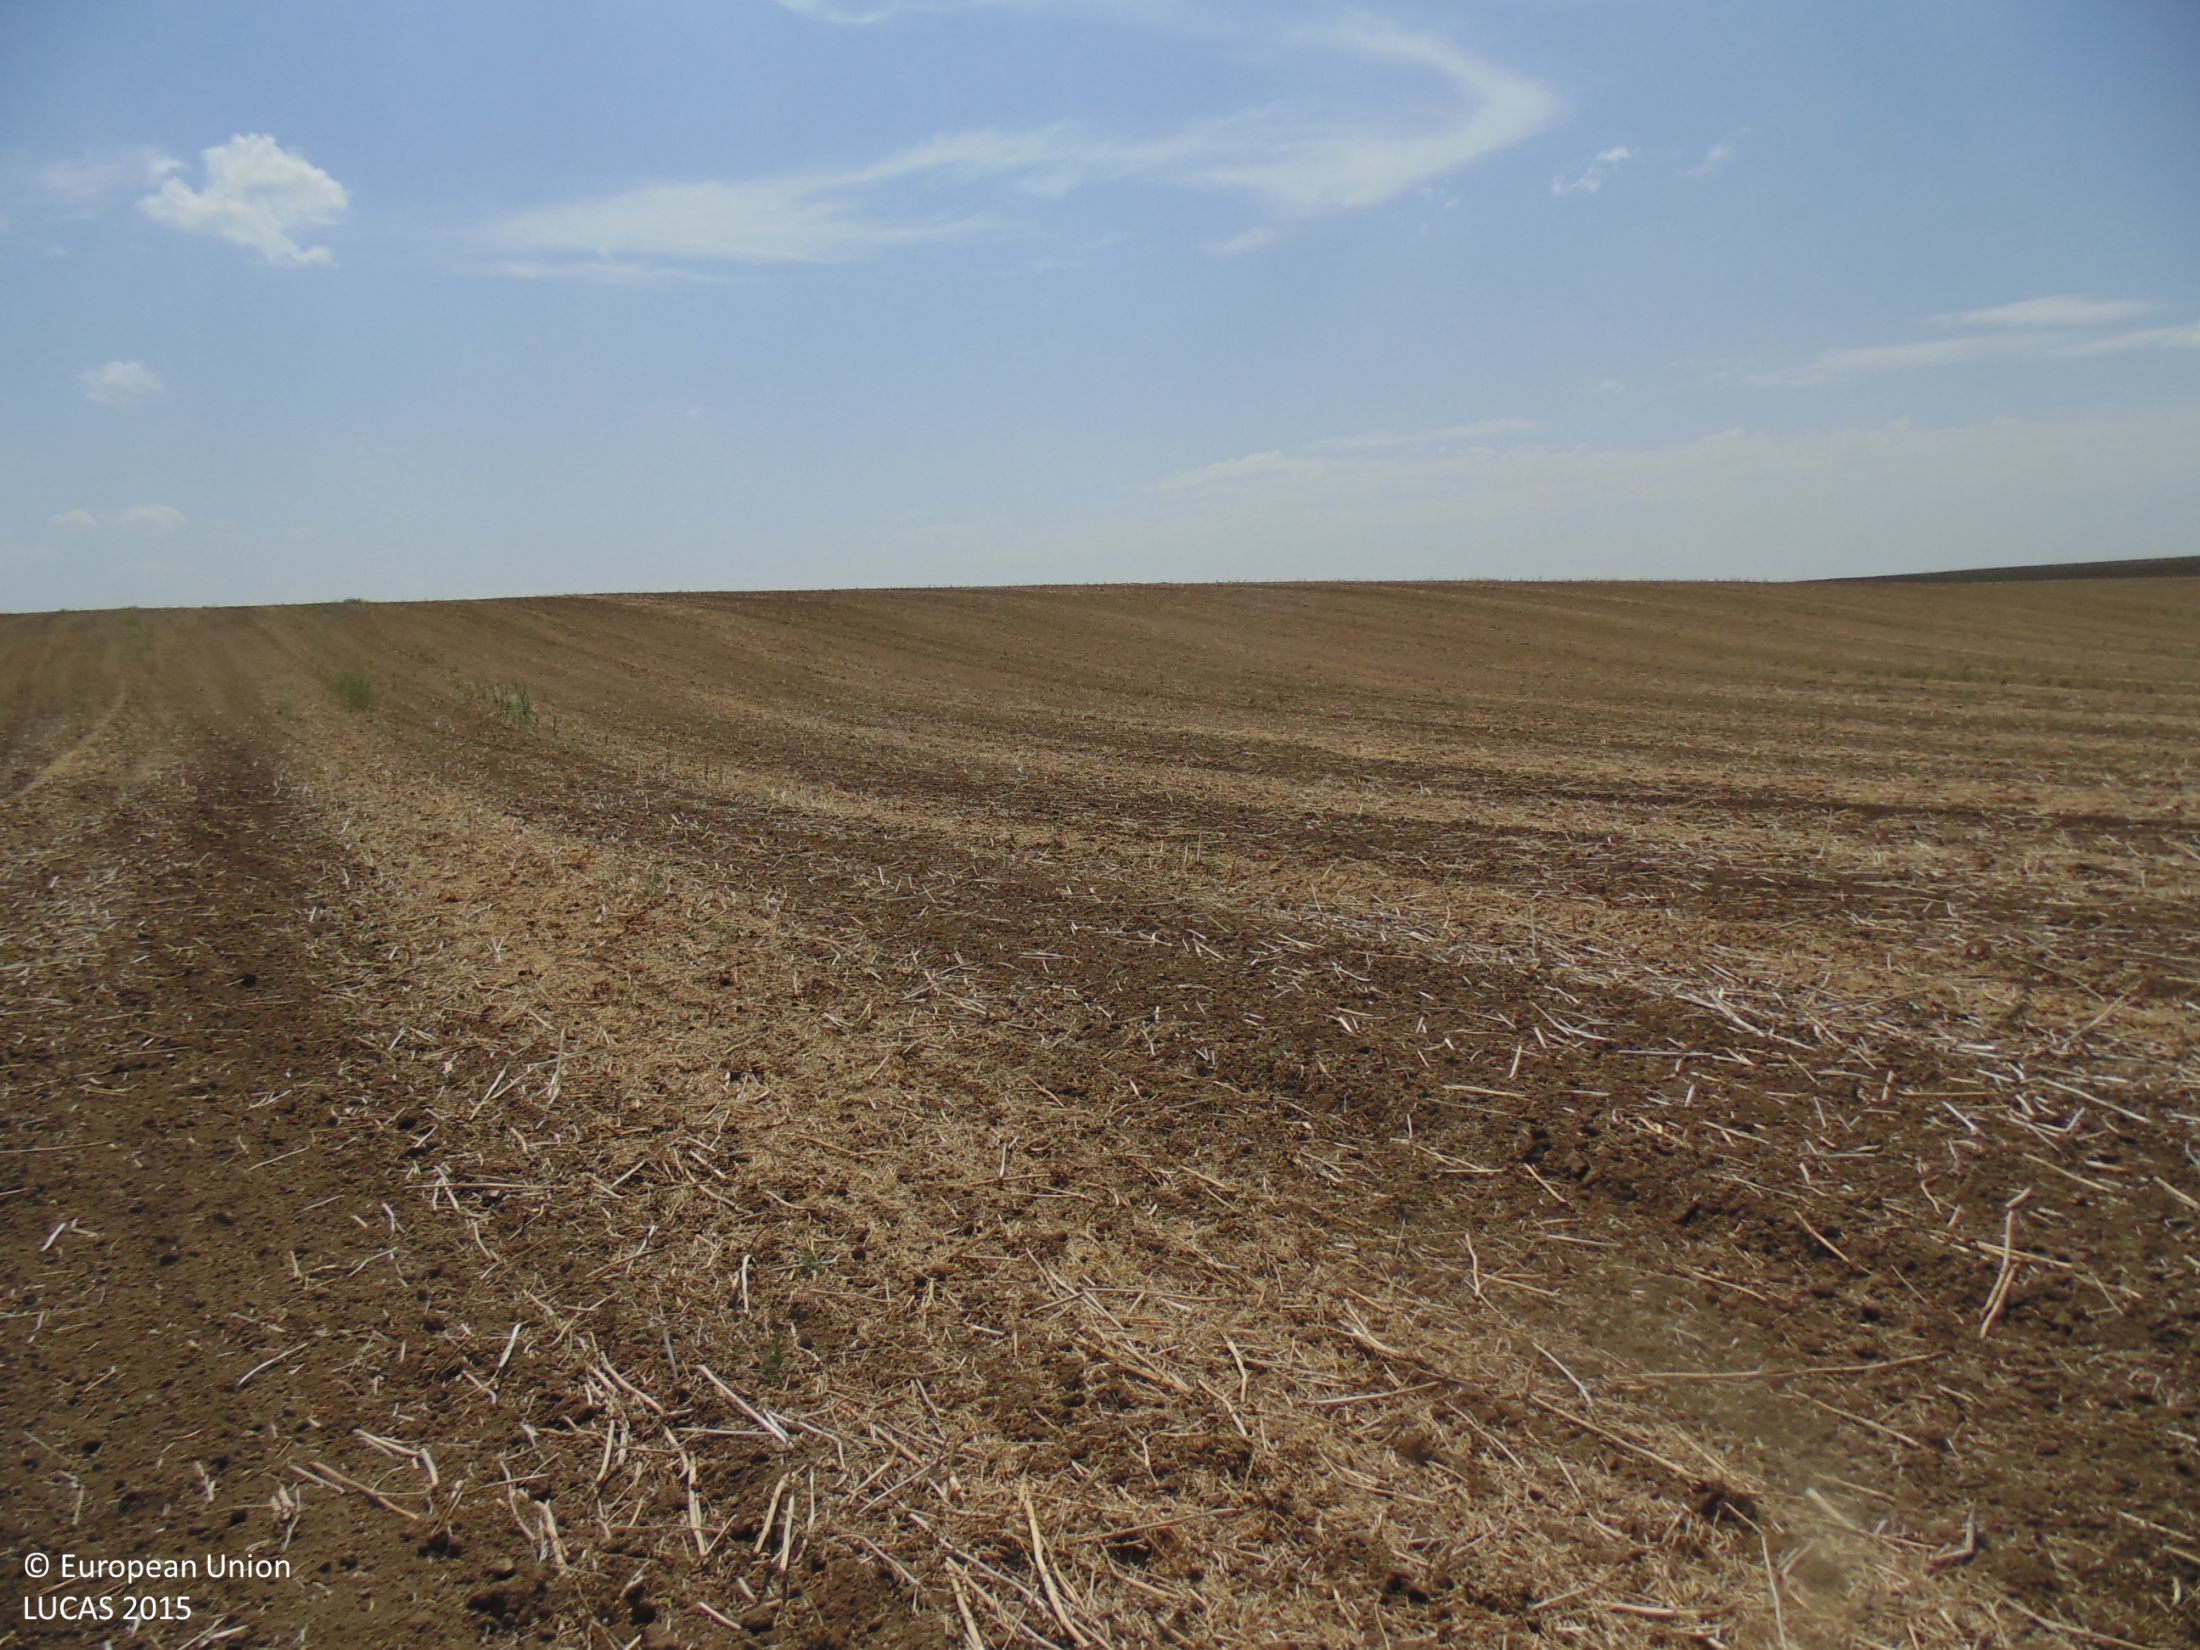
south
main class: Cropland
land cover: Rape and turnip rape
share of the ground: < 10 %
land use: Agriculture (excluding fallow land and kitchen gardens)
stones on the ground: < 10 %
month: August
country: BG
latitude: 43.9222
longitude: 27.7929
